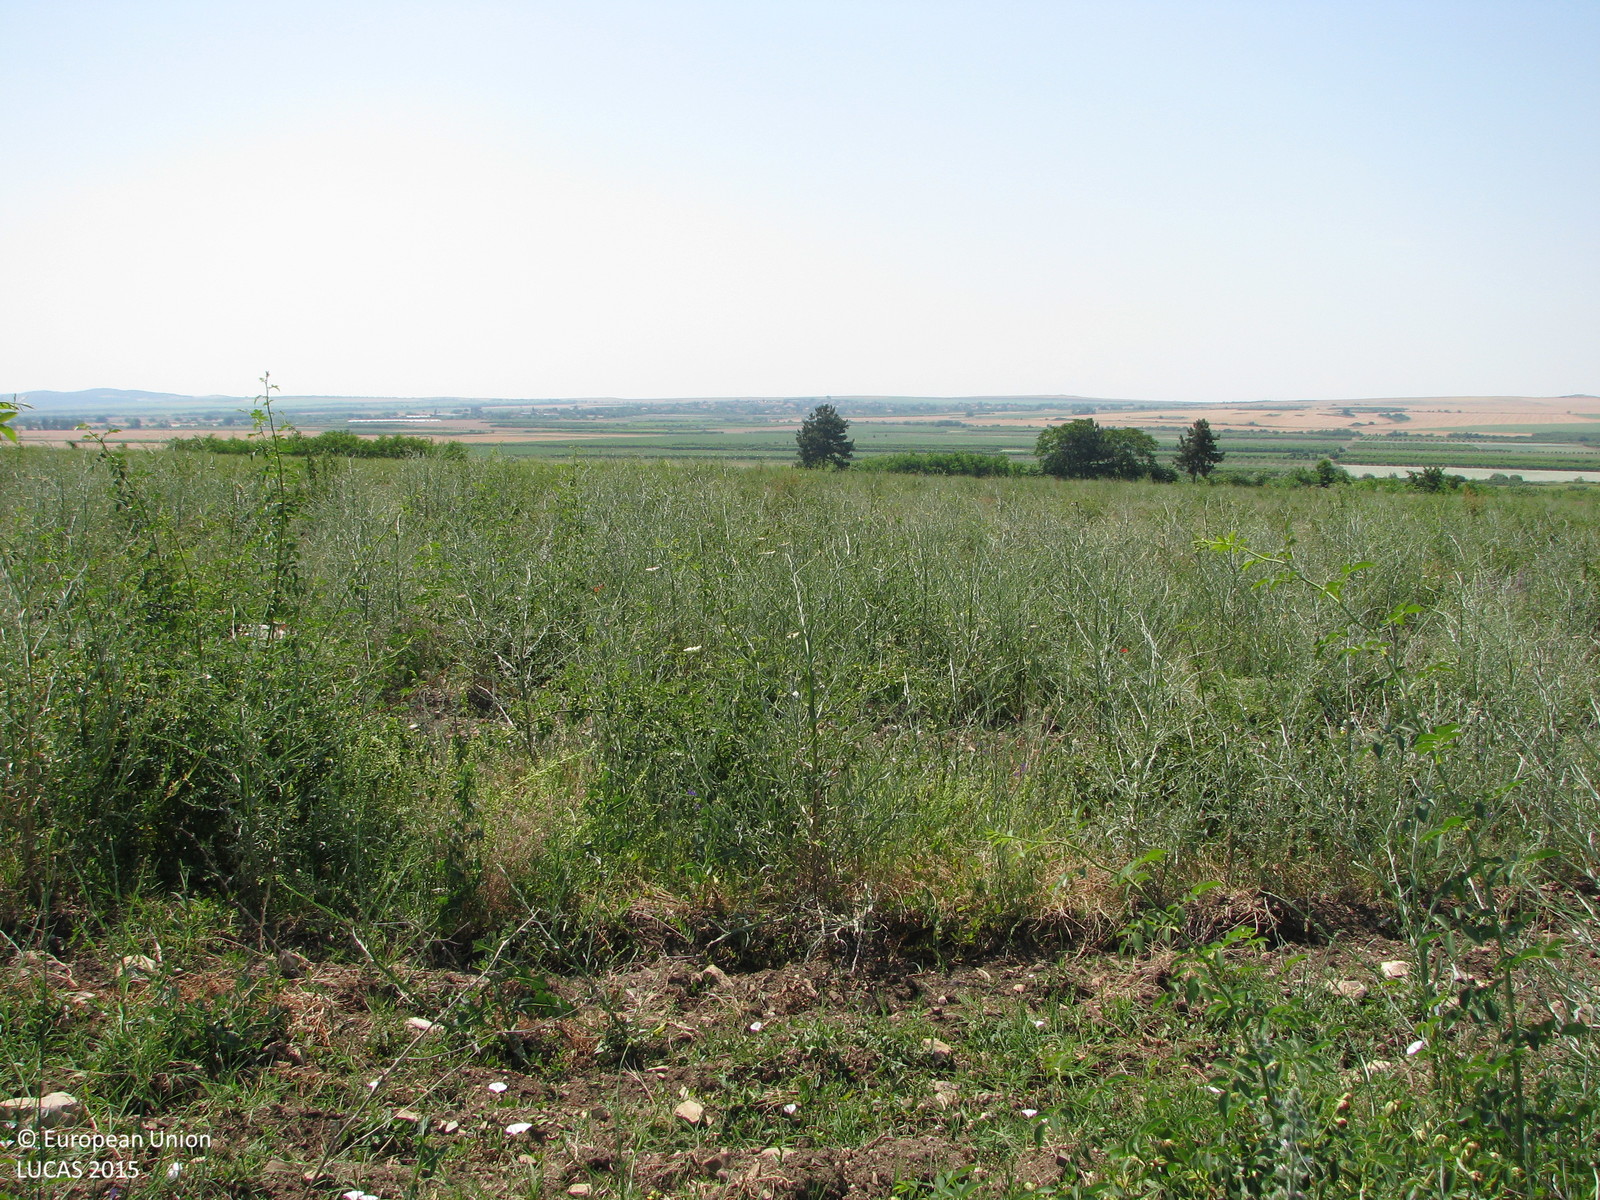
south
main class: Cropland
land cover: Other fruit trees and berries
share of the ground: < 10 %
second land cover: Spontaneously vegetated surfaces
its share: > 75 %
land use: Agriculture (excluding fallow land and kitchen gardens)
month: June
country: BG
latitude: 42.6059
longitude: 26.2131
